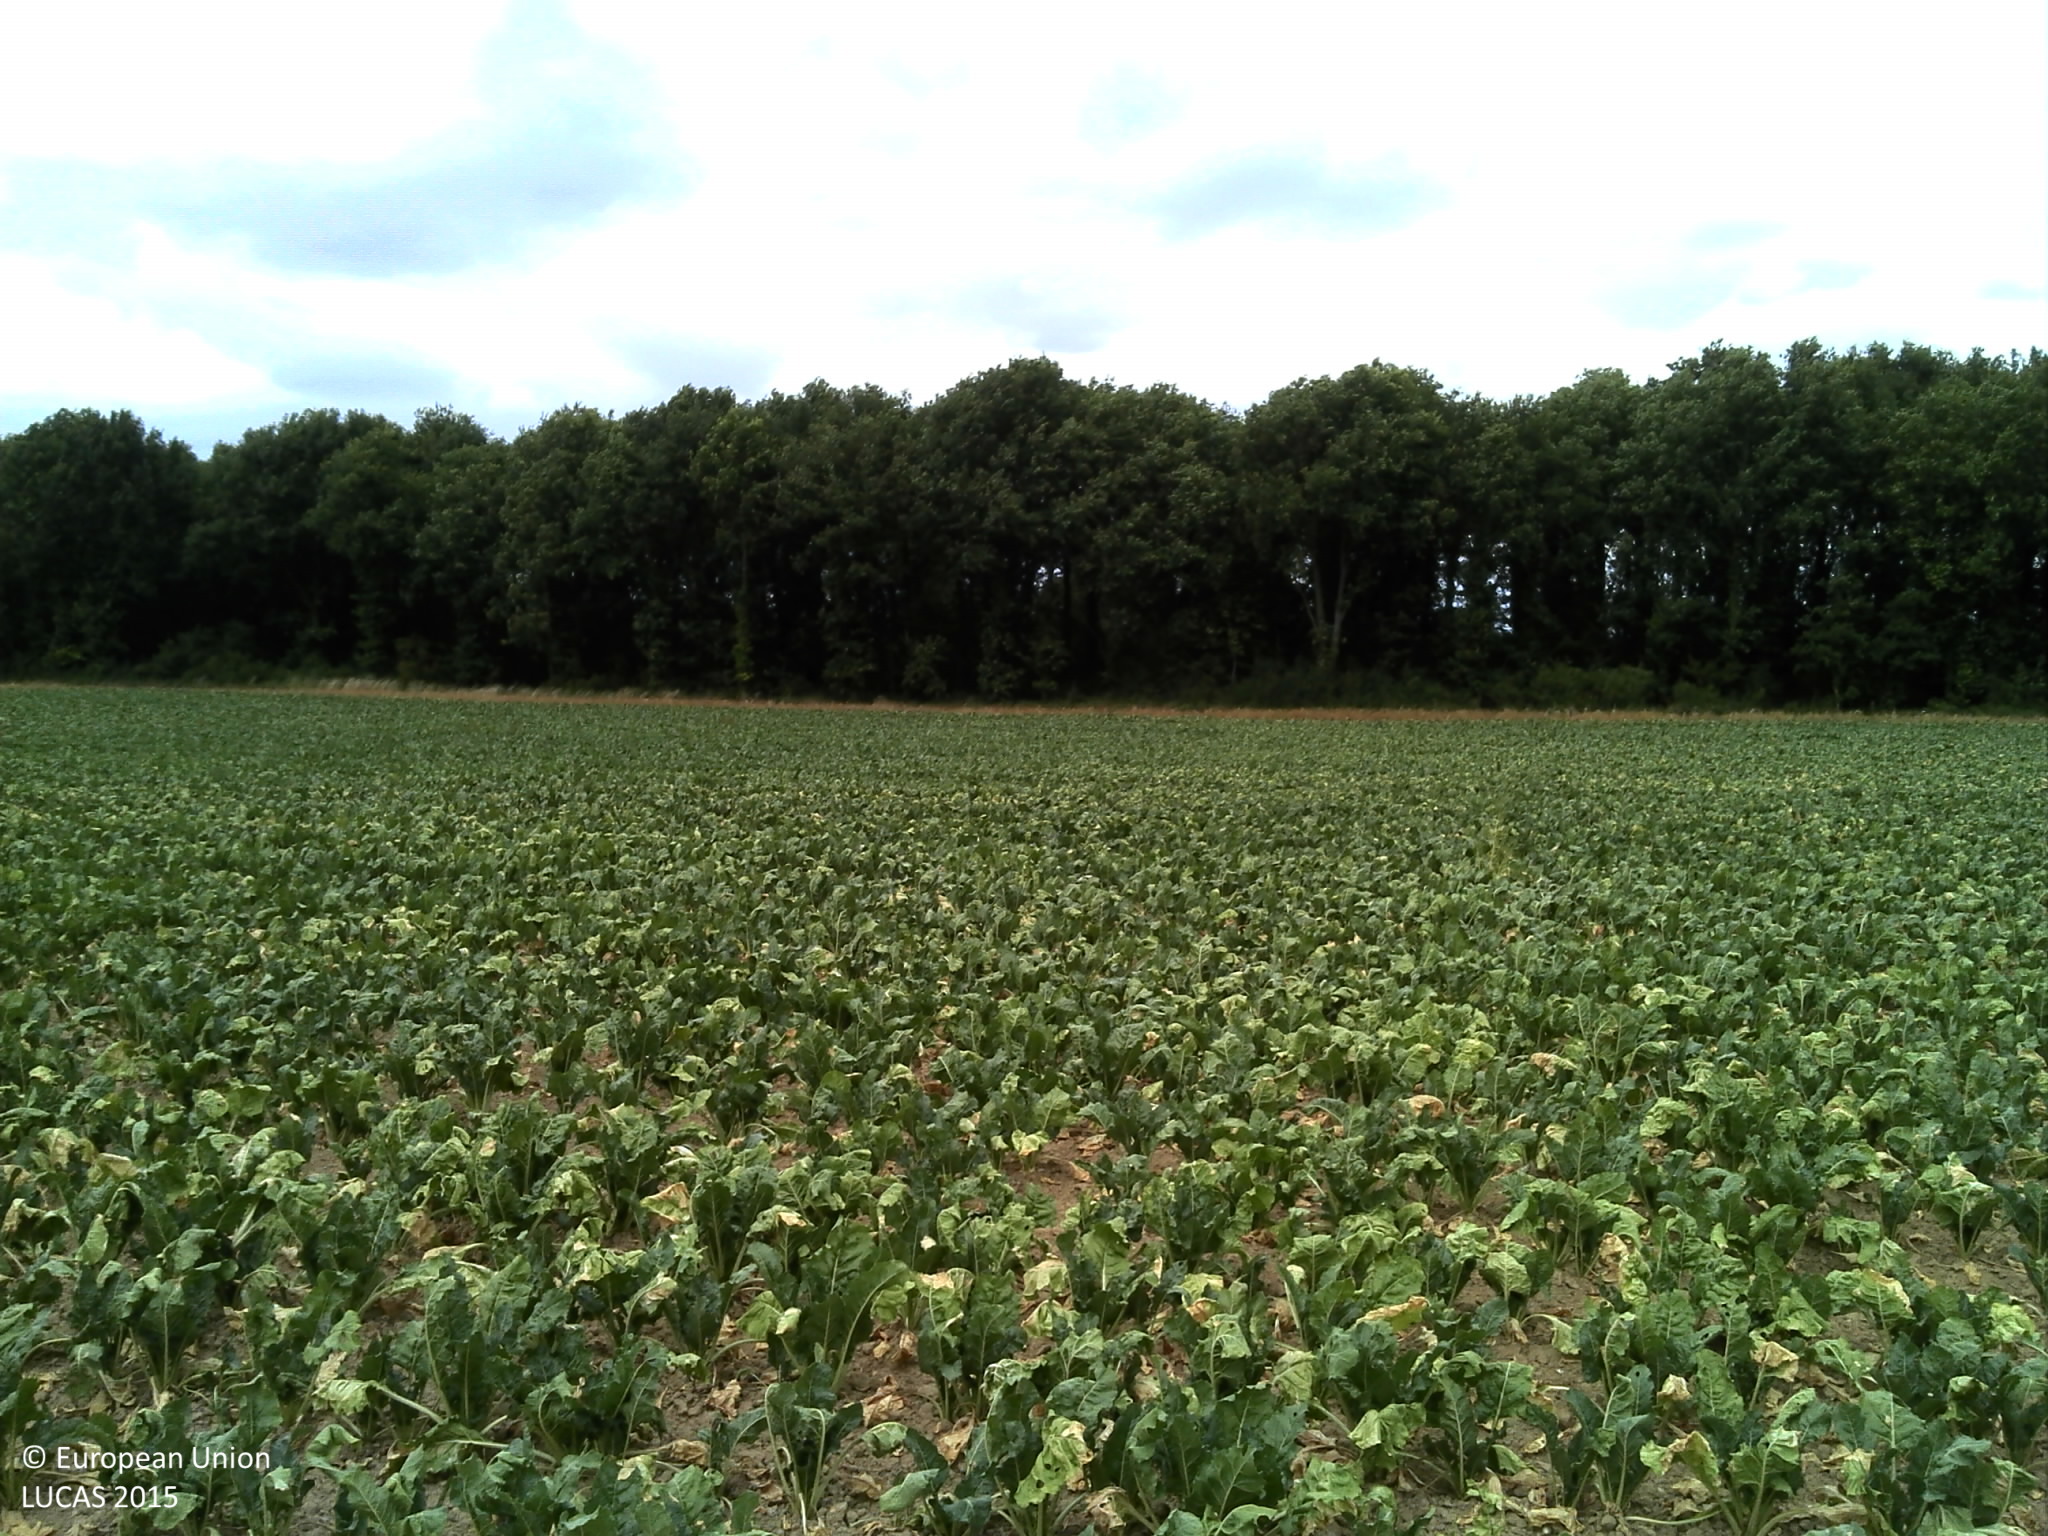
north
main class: Cropland
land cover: Sugar beet
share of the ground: 50 - 75 %
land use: Agriculture (excluding fallow land and kitchen gardens)
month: July
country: FR
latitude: 48.4905
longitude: 2.4795
